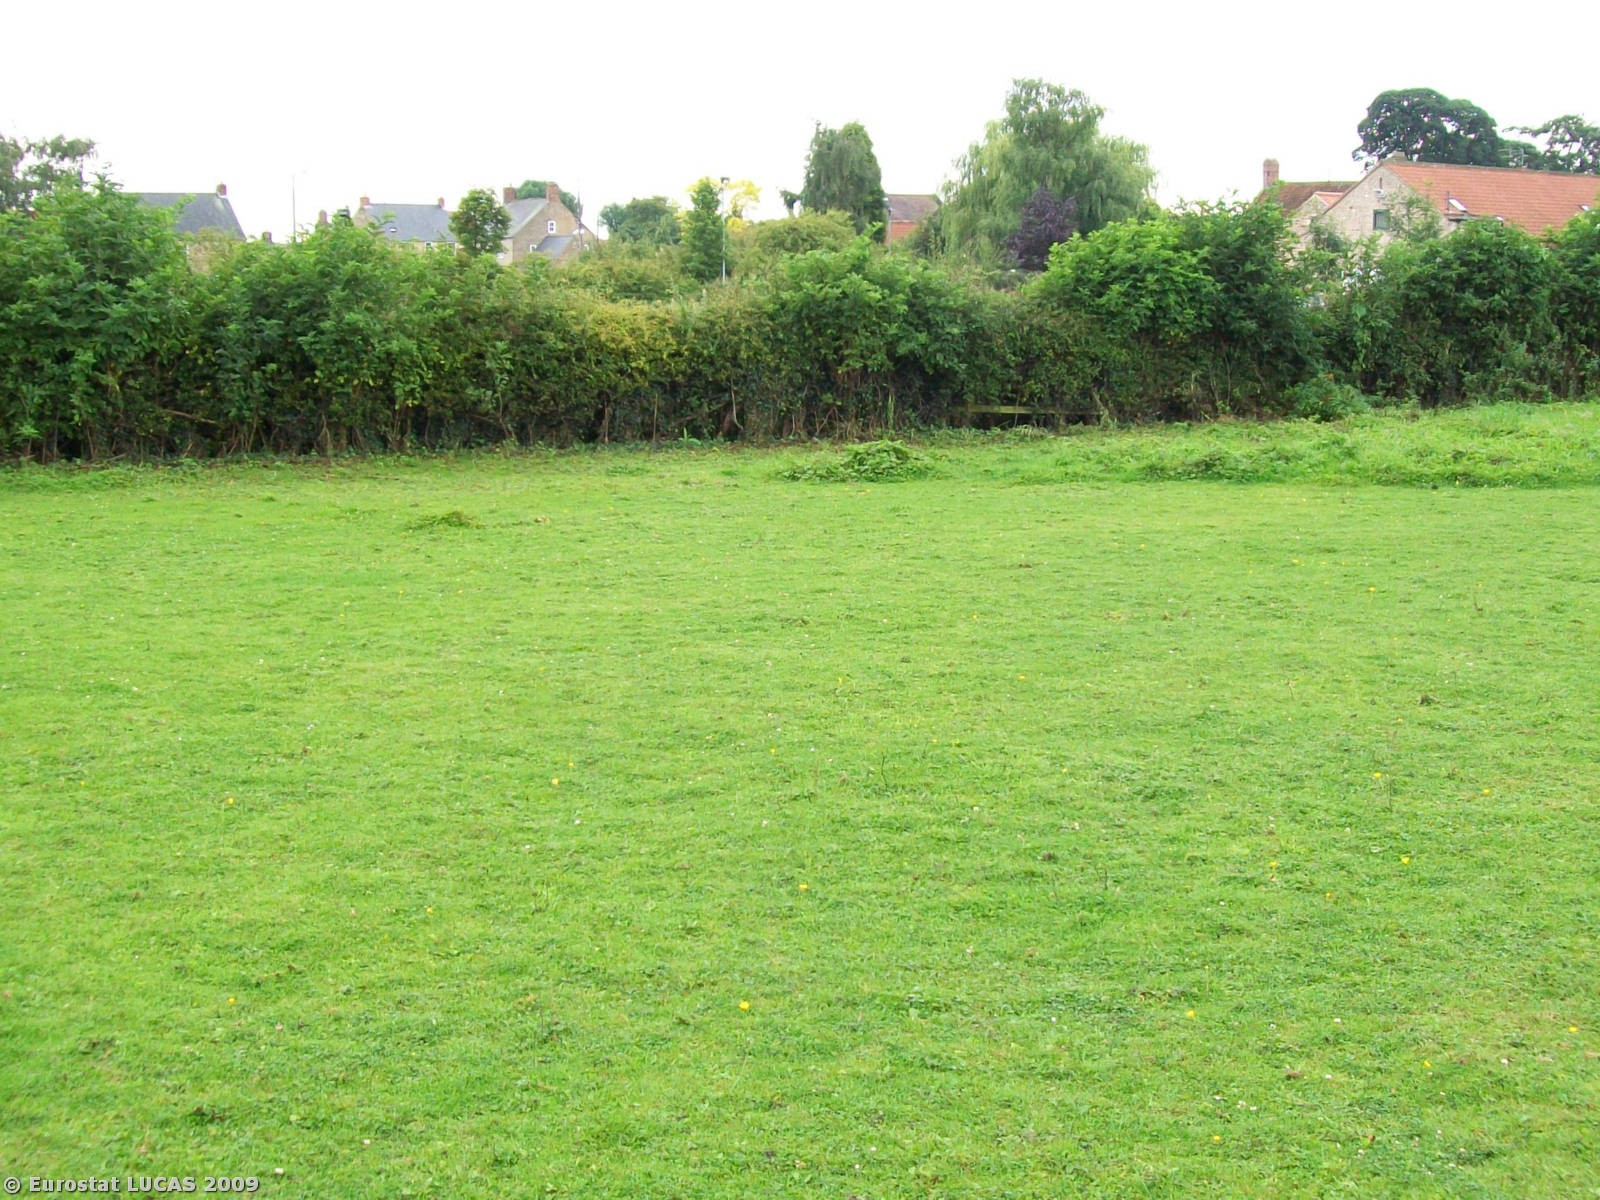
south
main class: Grassland
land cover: Grassland without tree/shrub cover
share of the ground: > 75 %
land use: Agriculture (excluding fallow land and kitchen gardens)
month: August
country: GB
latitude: 53.2904
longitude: -1.2834
